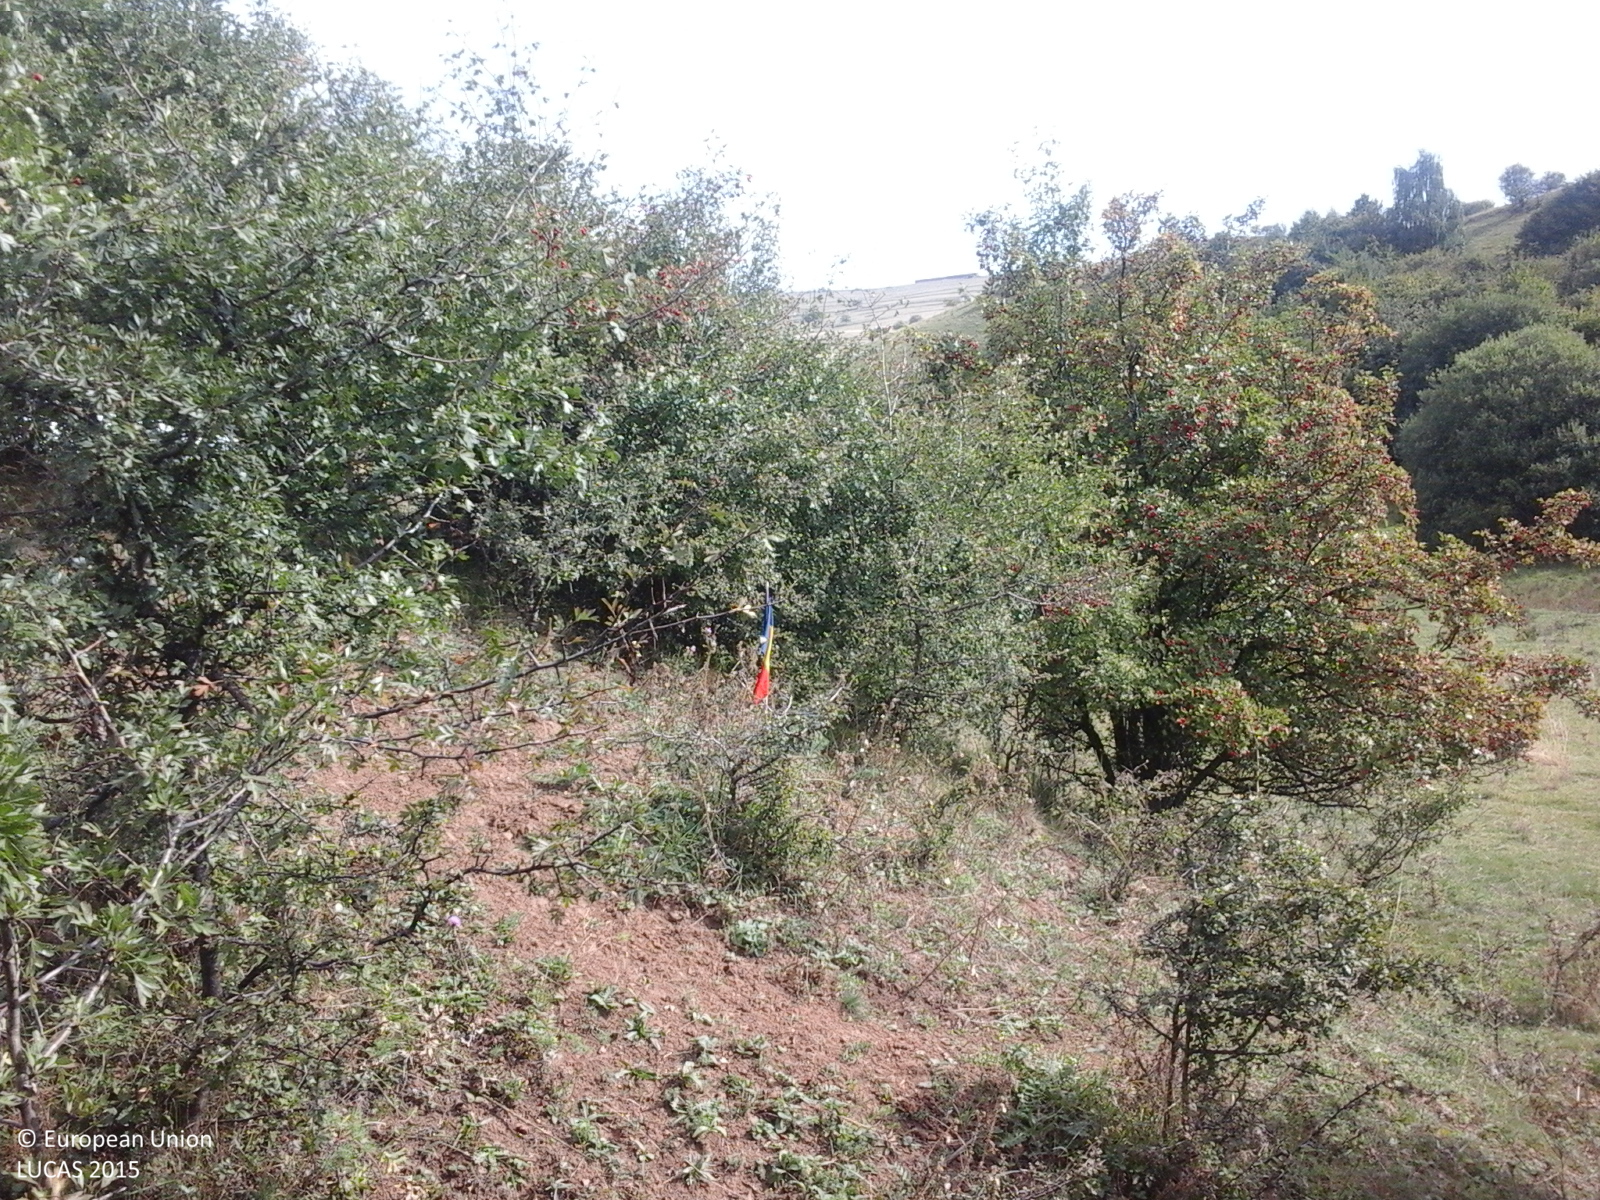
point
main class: Grassland
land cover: Grassland with sparse tree/shrub cover
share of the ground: > 75 %
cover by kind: herbaceous plants 85 %, shrubs 10 %, broadleaved forest trees 5 %
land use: Agriculture (excluding fallow land and kitchen gardens)
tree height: < 5 m
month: September
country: RO
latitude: 46.6776
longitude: 23.4945
